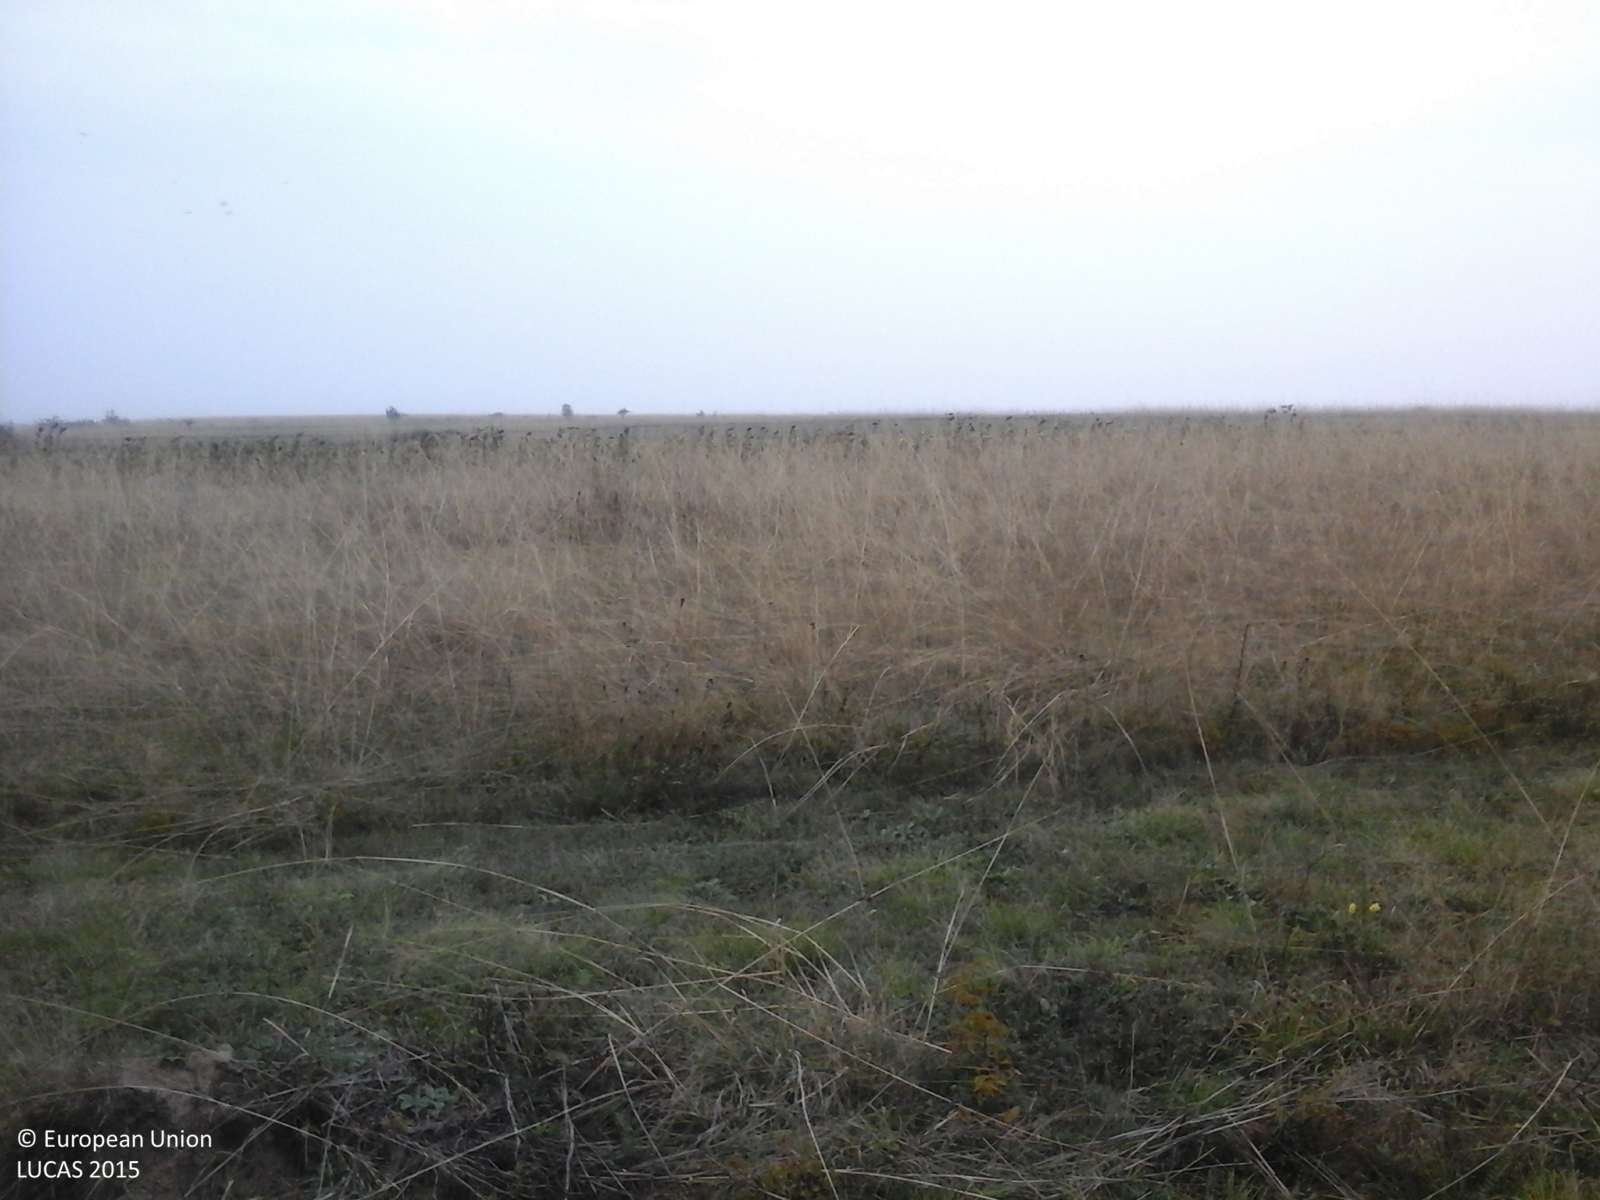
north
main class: Grassland
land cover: Grassland without tree/shrub cover
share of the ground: > 75 %
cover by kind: herbaceous plants 100 %
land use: Agriculture (excluding fallow land and kitchen gardens)
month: September
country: RO
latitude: 44.9556
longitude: 23.4033
